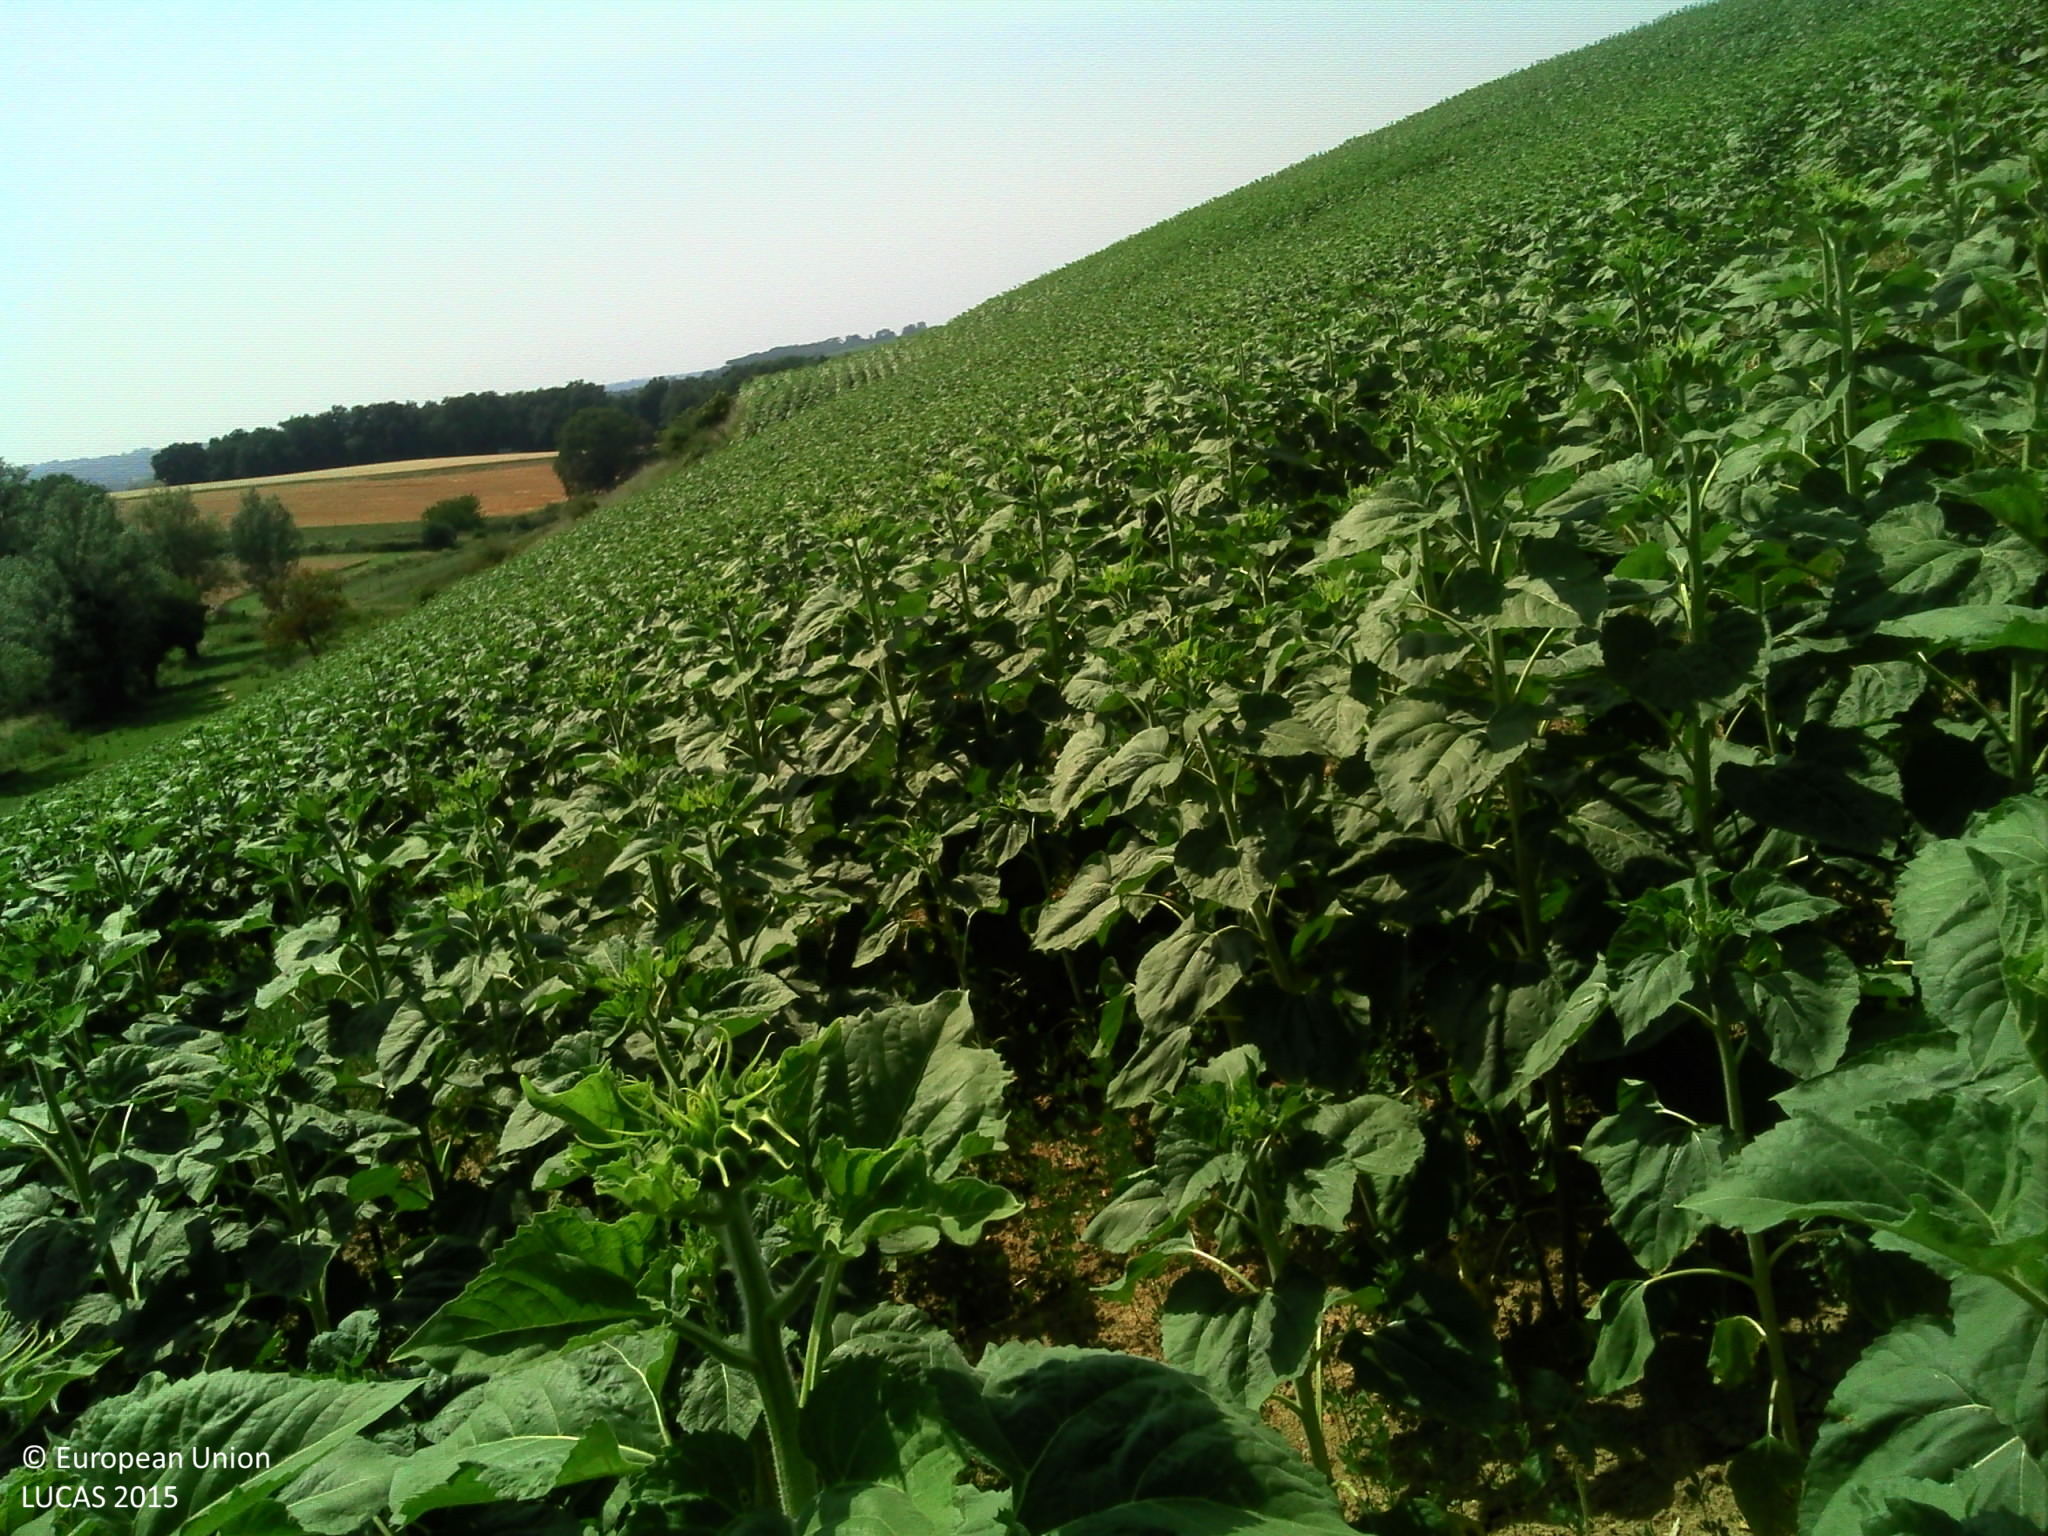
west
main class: Cropland
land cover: Sunflower
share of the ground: > 75 %
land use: Agriculture (excluding fallow land and kitchen gardens)
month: July
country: FR
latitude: 43.6856
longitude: 1.6292
